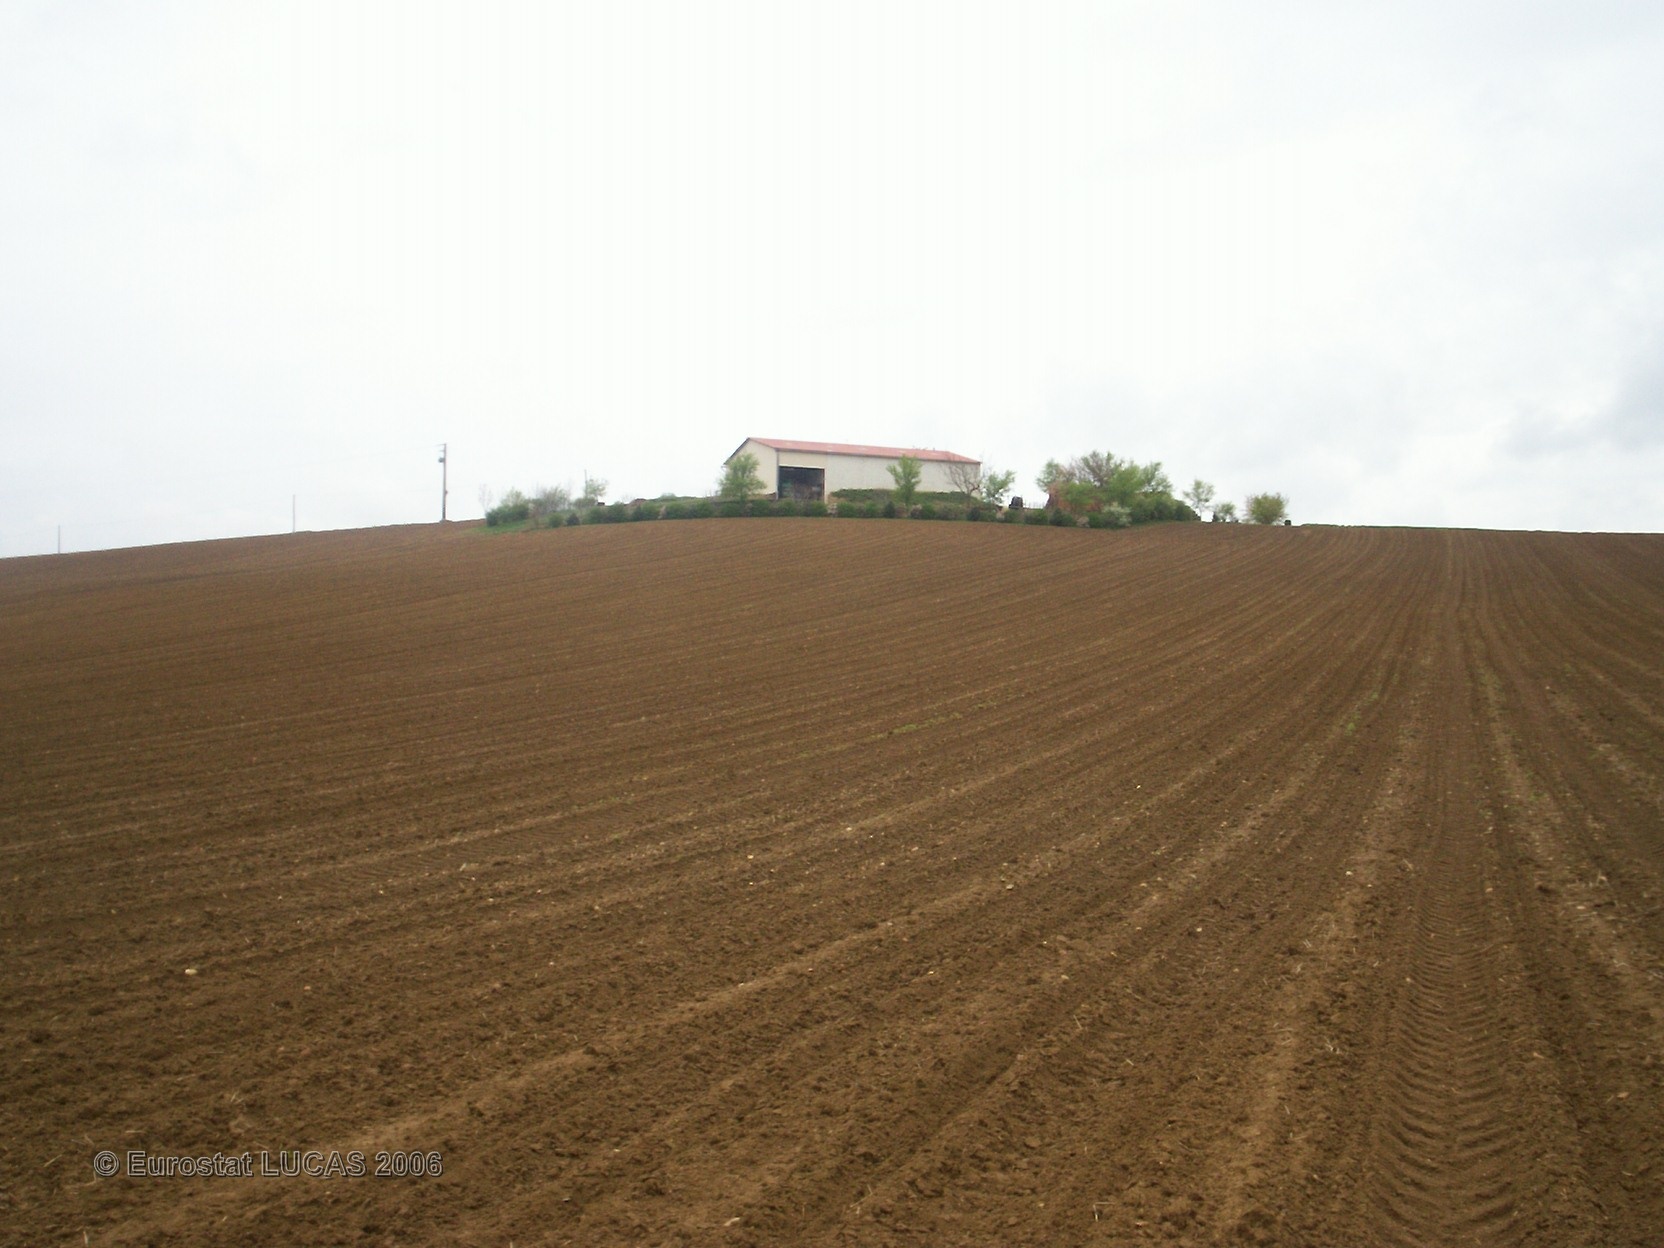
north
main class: Bare land
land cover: Bare land
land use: Agriculture (excluding fallow land and kitchen gardens)
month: April
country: FR
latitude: 43.8504
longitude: 1.0051
